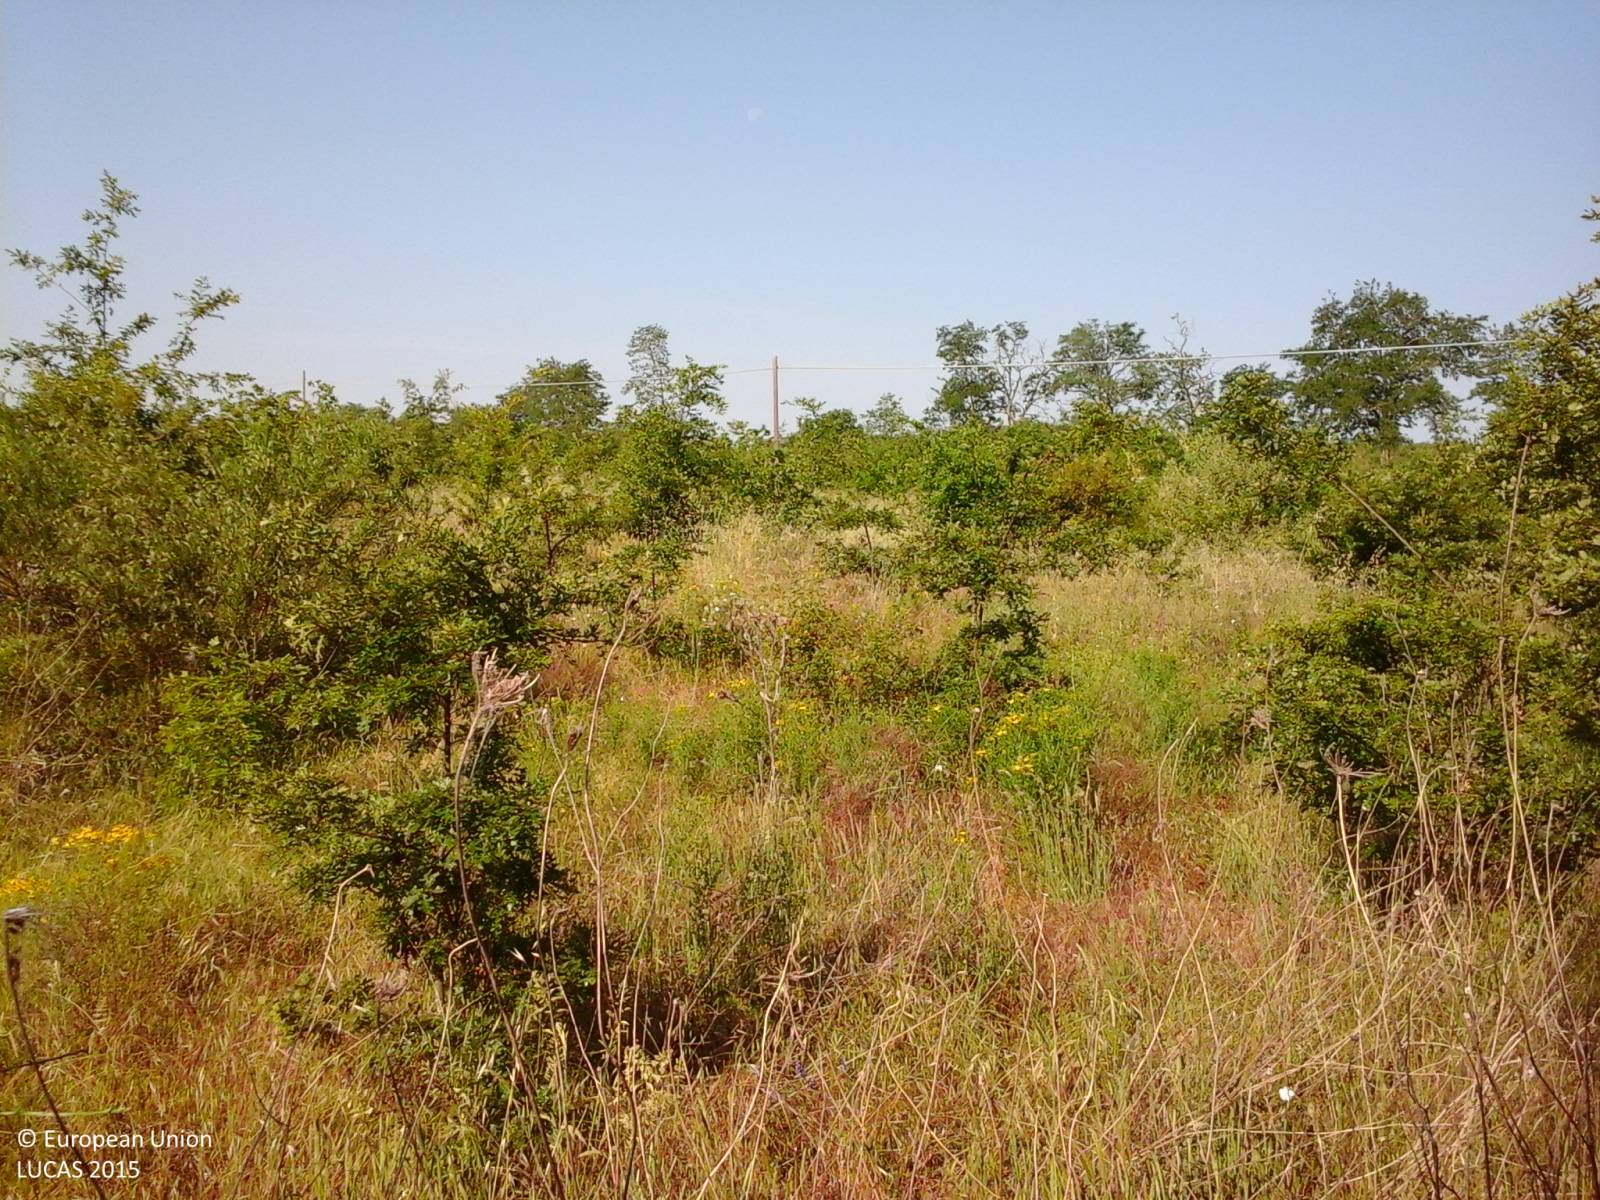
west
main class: Woodland
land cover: Broadleaved woodland
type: thermophilous deciduous forest
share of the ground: > 75 %
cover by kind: broadleaved forest trees 90 %, shrubs 10 %
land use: Forestry
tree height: > 5 m
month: June
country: IT
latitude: 42.6151
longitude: 12.0535
